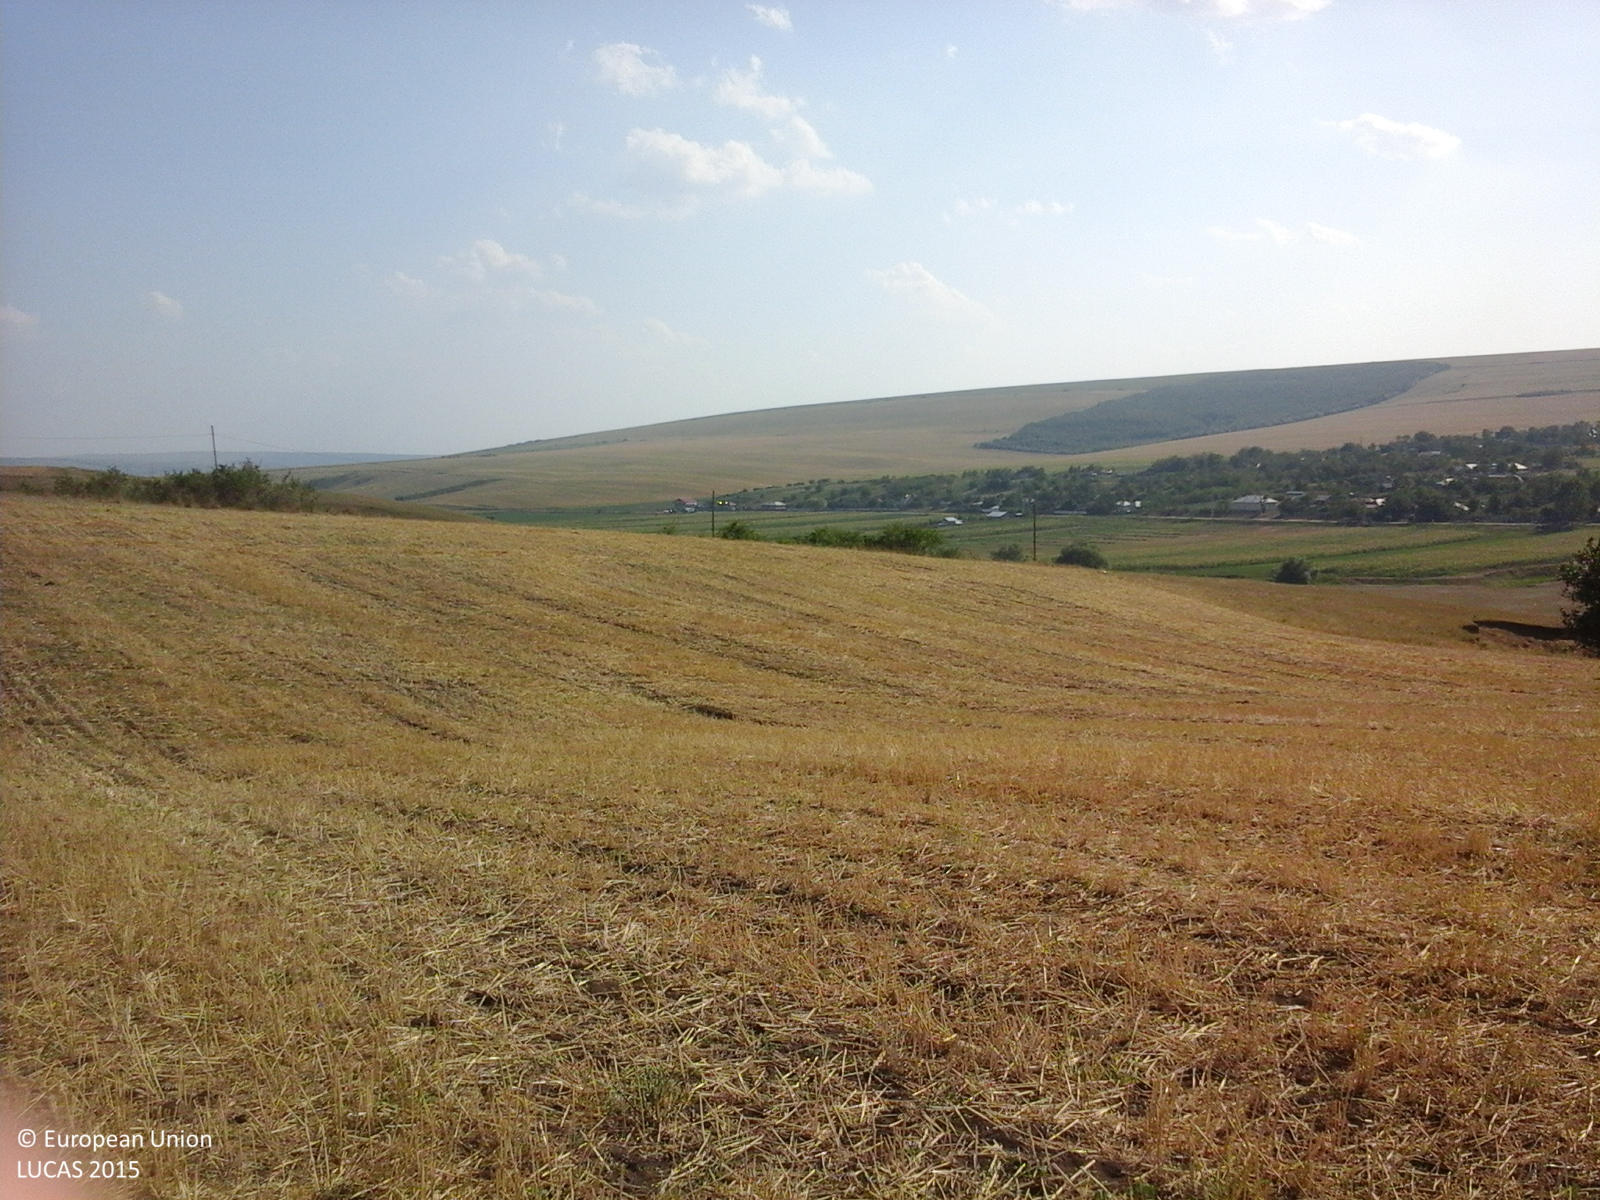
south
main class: Cropland
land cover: Common wheat
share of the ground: < 10 %
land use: Agriculture (excluding fallow land and kitchen gardens)
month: July
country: RO
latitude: 46.3612
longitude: 27.7548
